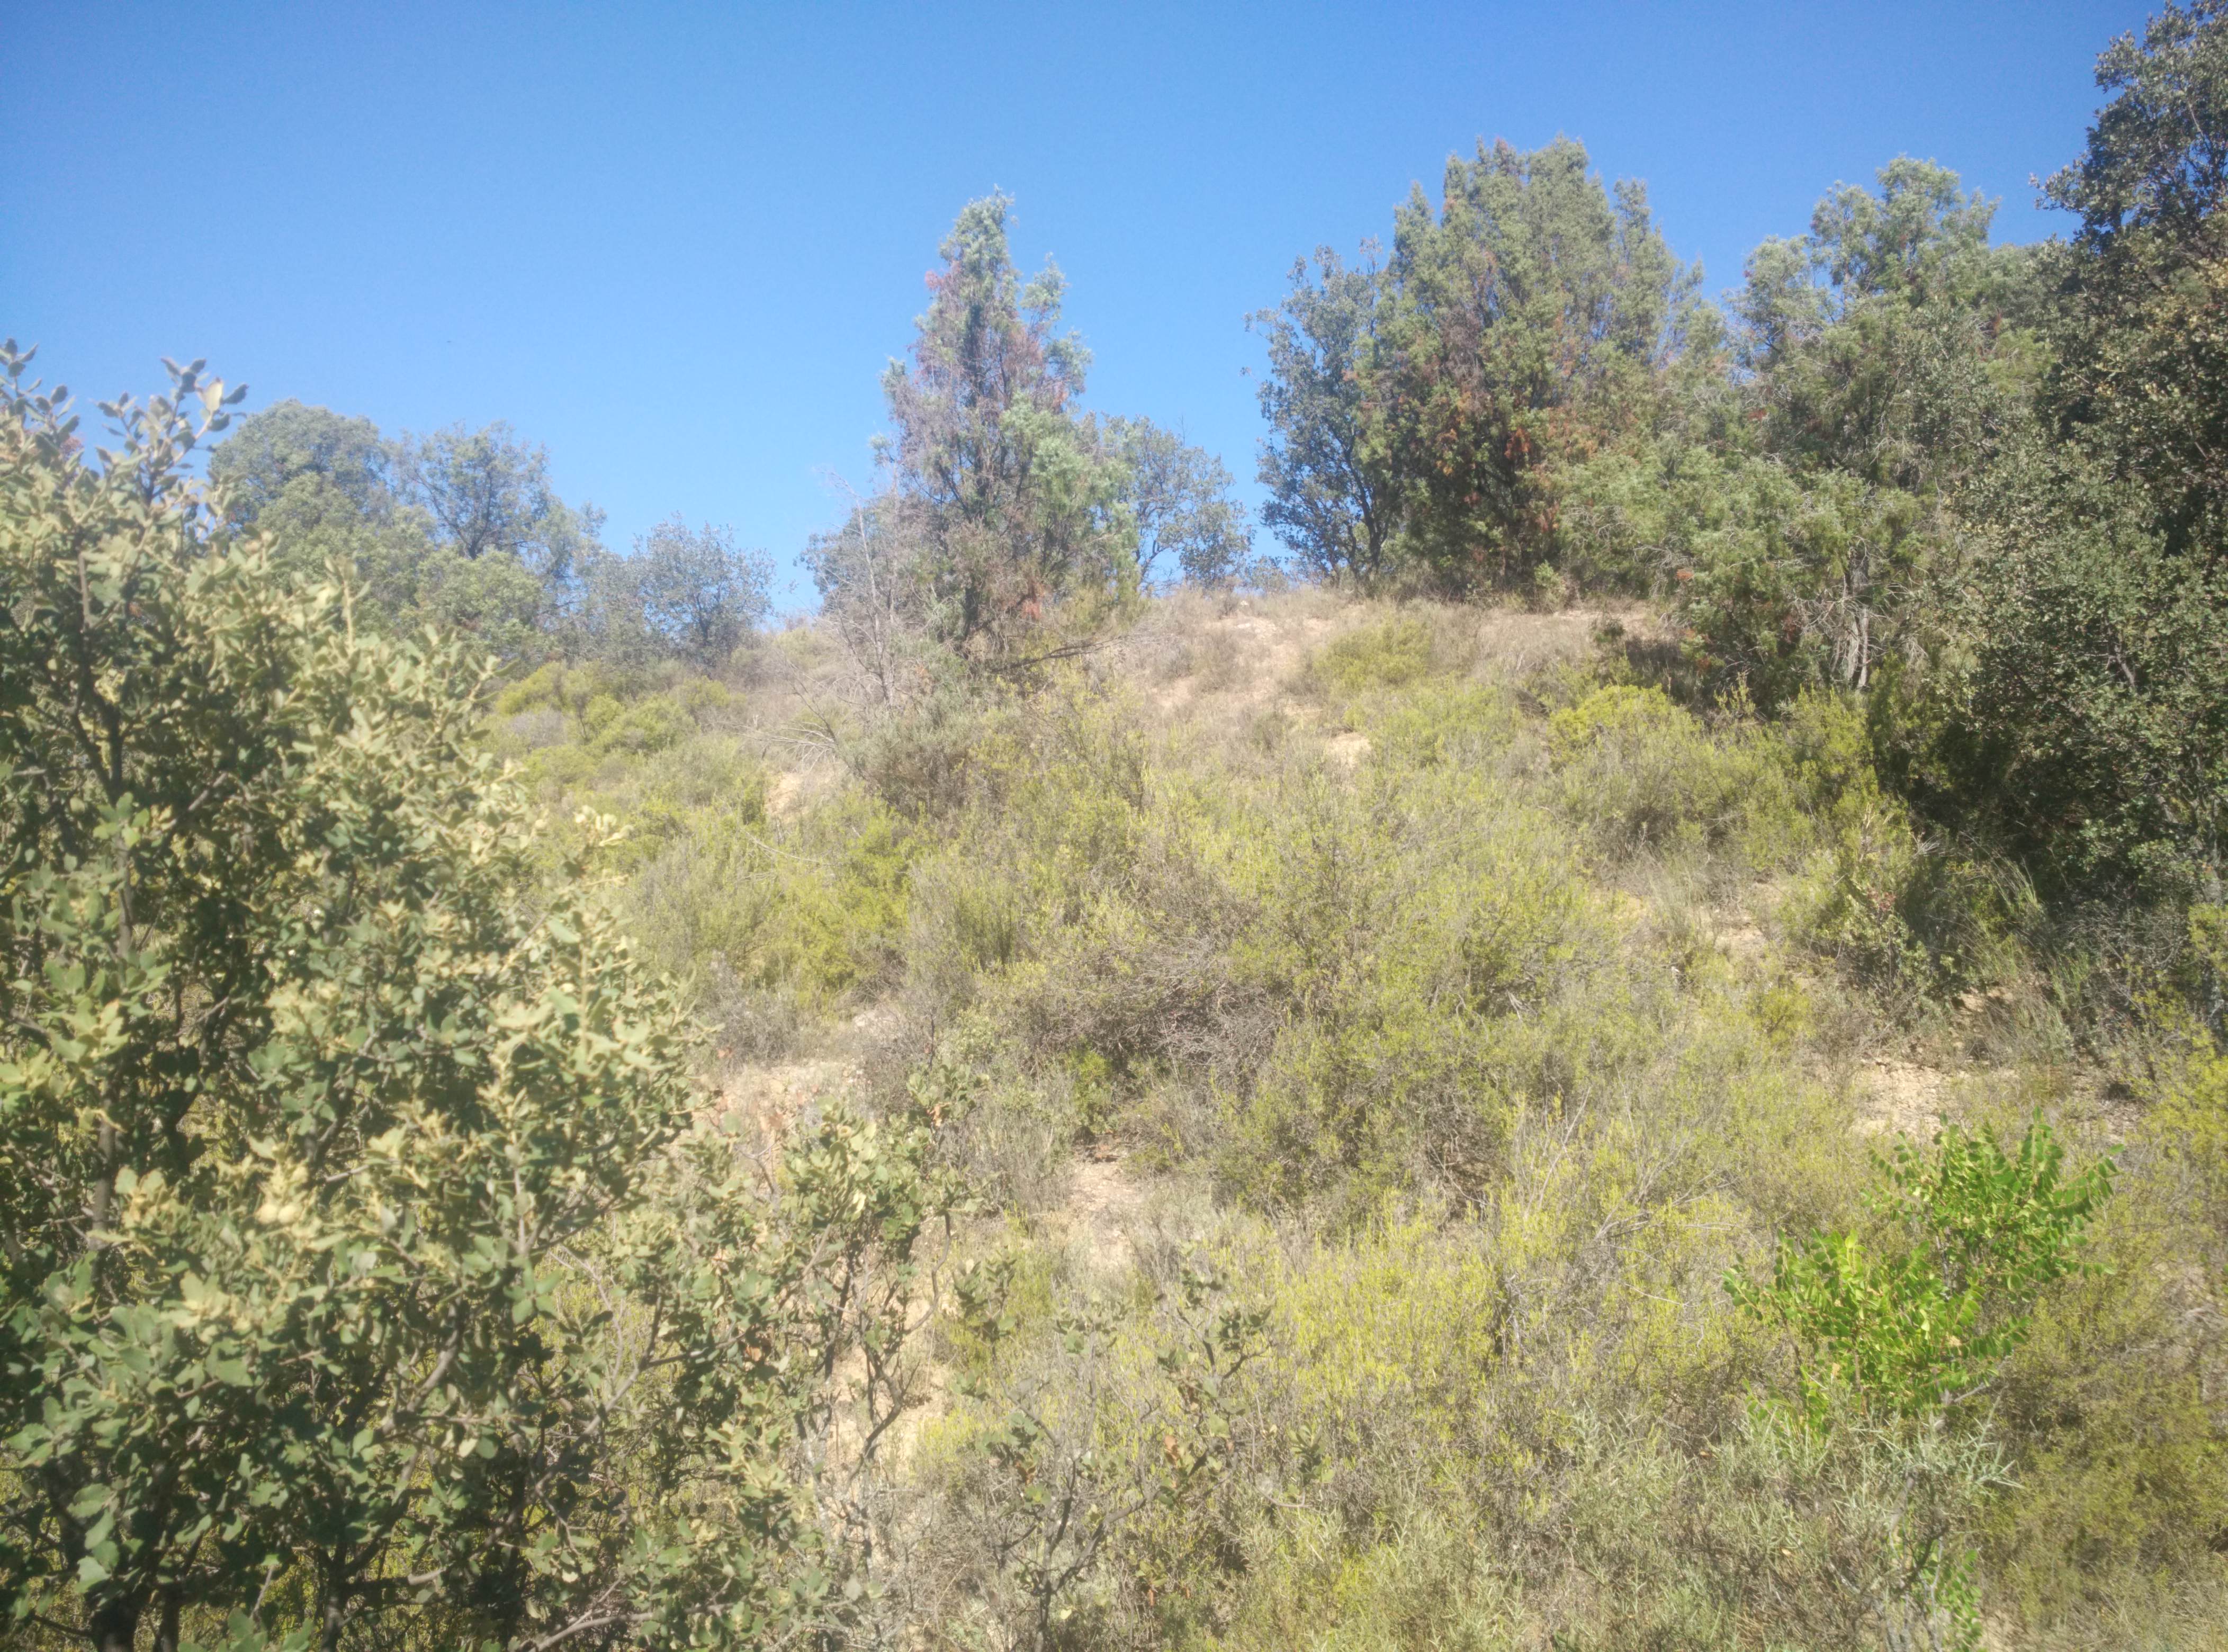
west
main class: Cropland
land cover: Olive groves
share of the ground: 10 - 25 %
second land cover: Shrubland without tree cover
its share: 50 - 75 %
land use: Agriculture (excluding fallow land and kitchen gardens)
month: July
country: ES
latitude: 40.7378
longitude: -2.8316
